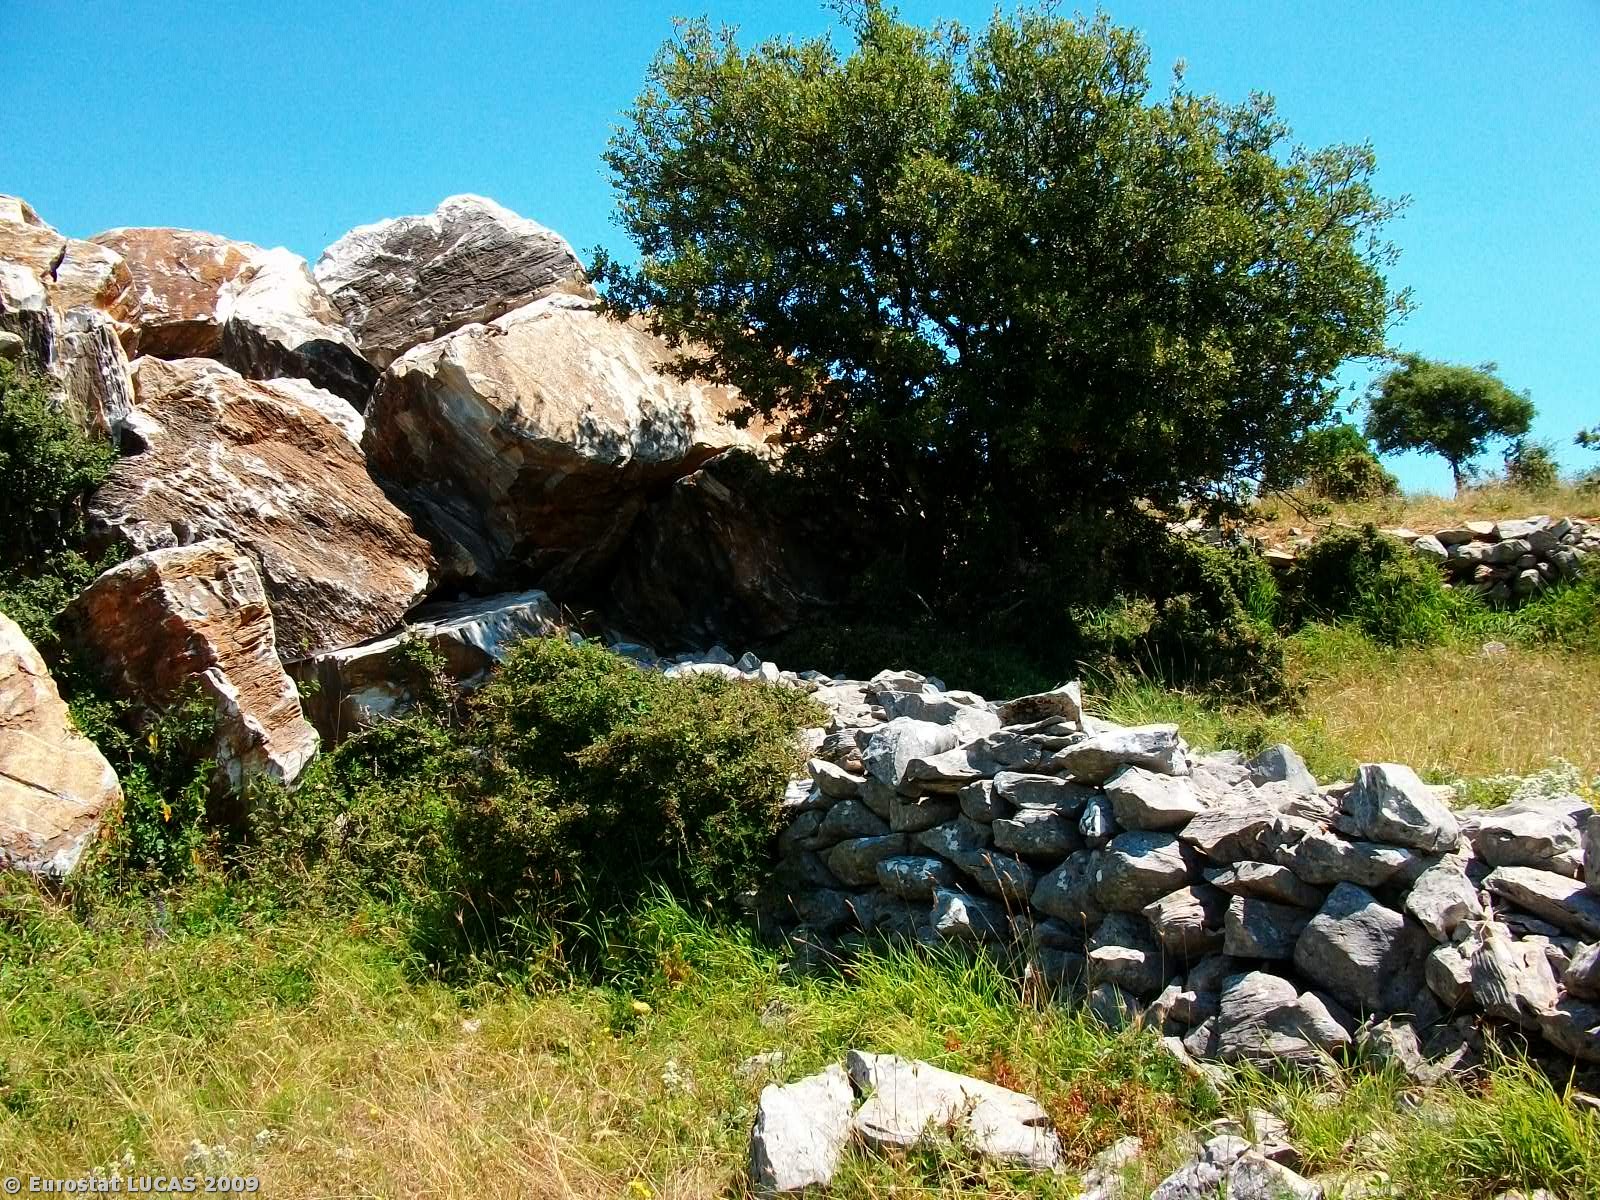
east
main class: Grassland
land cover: Grassland with sparse tree/shrub cover
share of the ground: > 75 %
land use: Agriculture (excluding fallow land and kitchen gardens)
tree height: < 5 m
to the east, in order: Grassland with sparse tree/shrub cover; Dry stone walls; Grassland without tree/shrub cover; Dry stone walls; Abandoned hedges; Grassland with sparse tree/shrub cover; Paved roads, cycling and walking lanes; Abandoned hedges; Grassland with sparse tree/shrub cover; Rock outcrops; Shruby margins; Grassland with sparse tree/shrub cover; Artificial constructions; Grassland with sparse tree/shrub cover
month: May
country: GR
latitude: 41.0554
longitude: 24.3694
